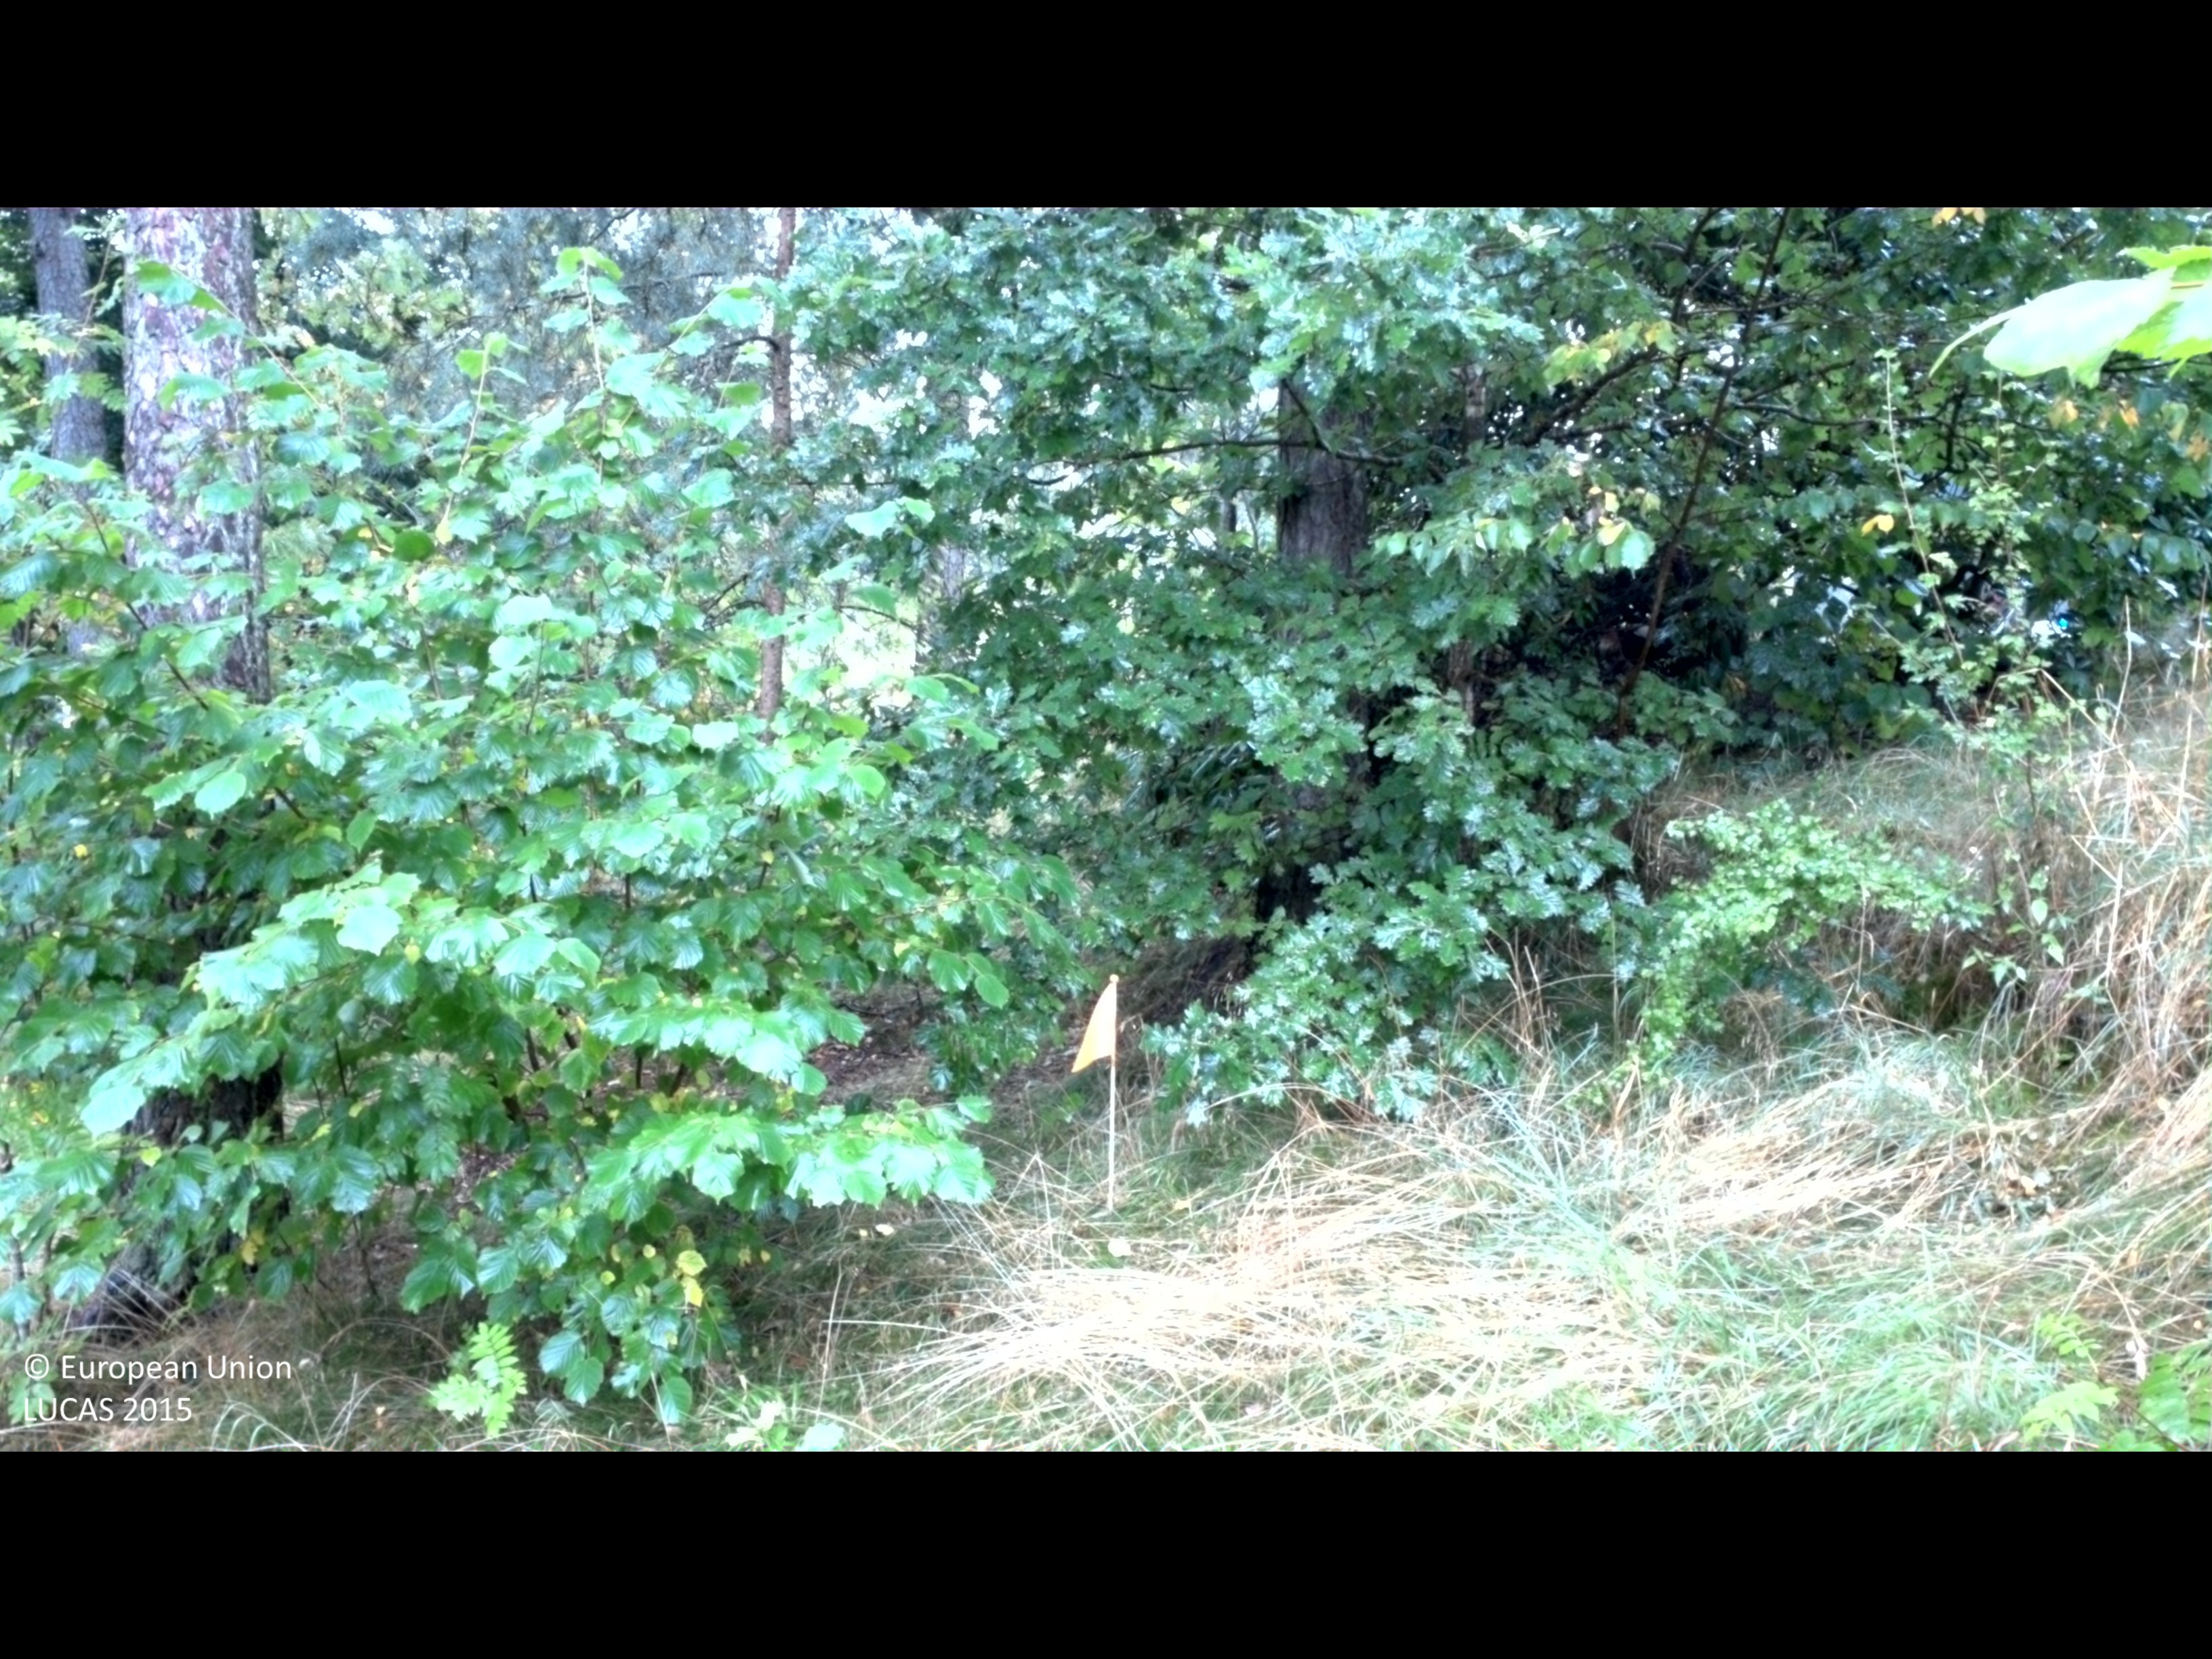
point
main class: Woodland
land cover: Pine dominated mixed woodland
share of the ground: 50 - 75 %
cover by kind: coniferous forest trees 45 %, herbaceous plants 25 %, broadleaved forest trees 20 %, shrubs 10 %
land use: Residential
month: August
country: SE
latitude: 56.9591
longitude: 13.1374
